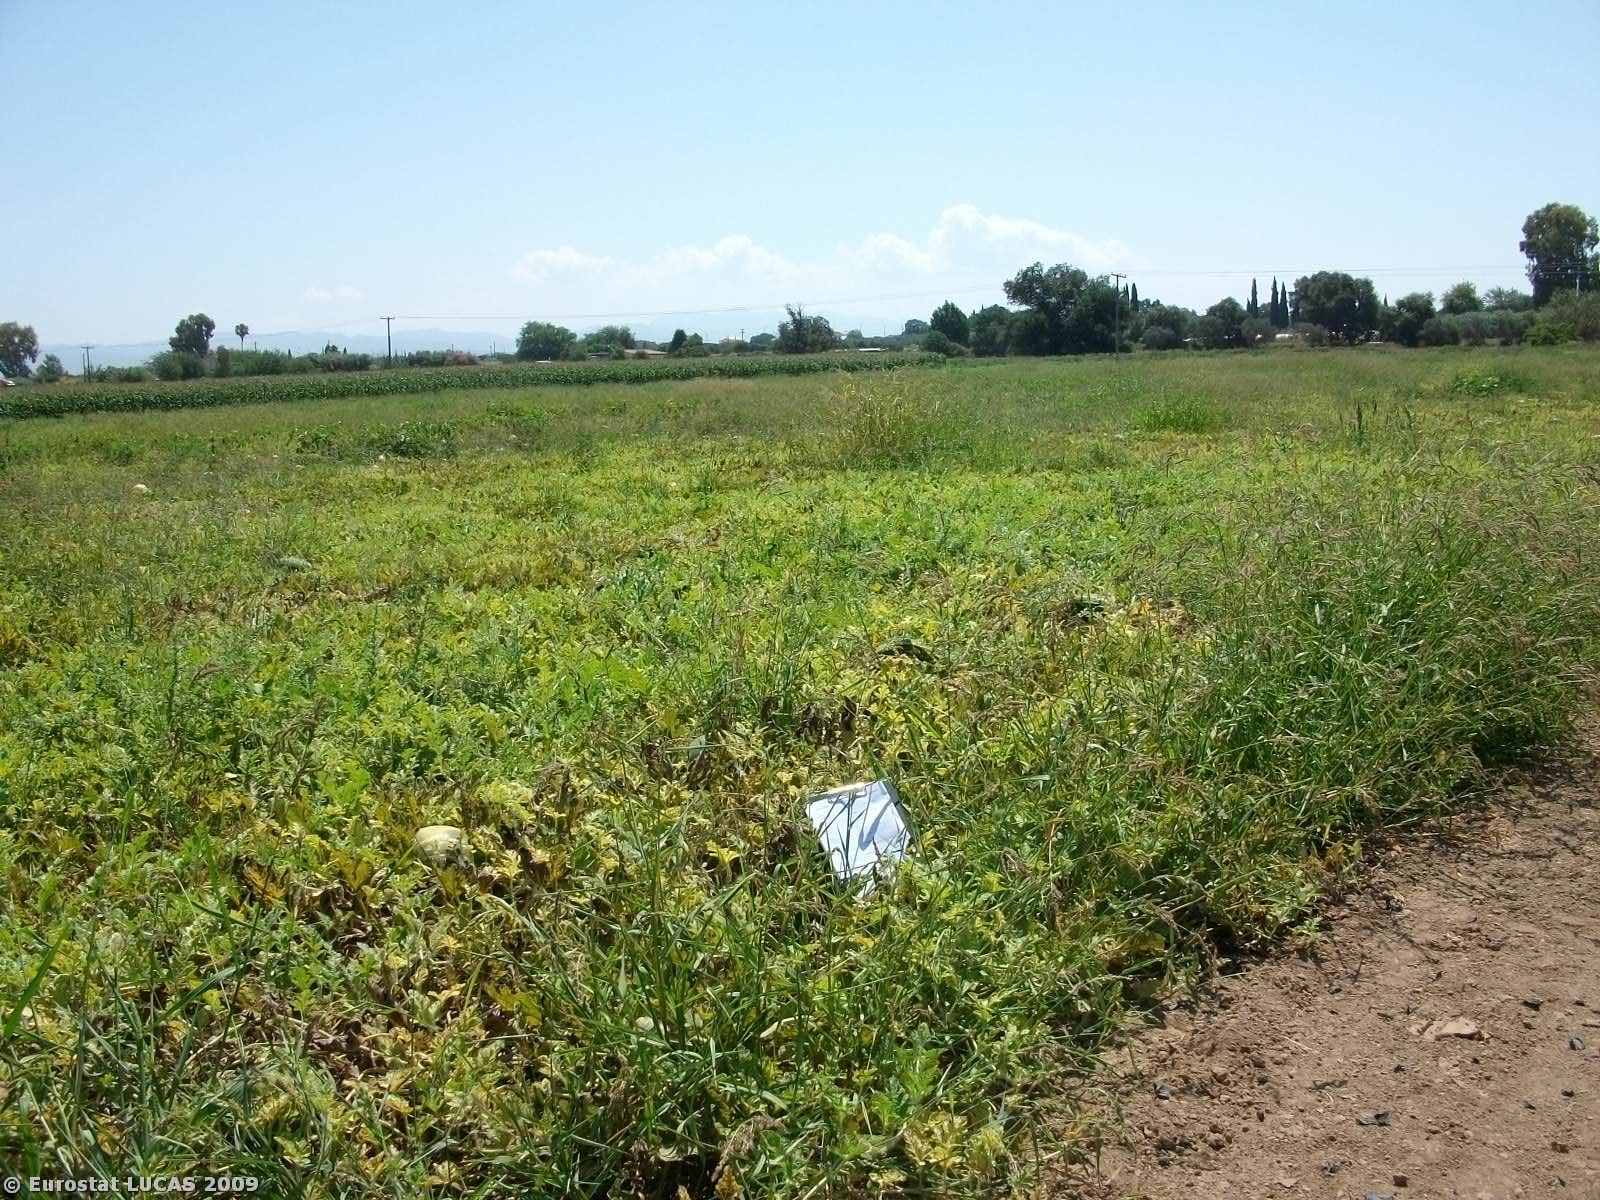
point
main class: Cropland
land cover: Other fresh vegetables
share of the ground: 50 - 75 %
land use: Agriculture (excluding fallow land and kitchen gardens)
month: July
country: GR
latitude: 38.0179
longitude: 21.3418
